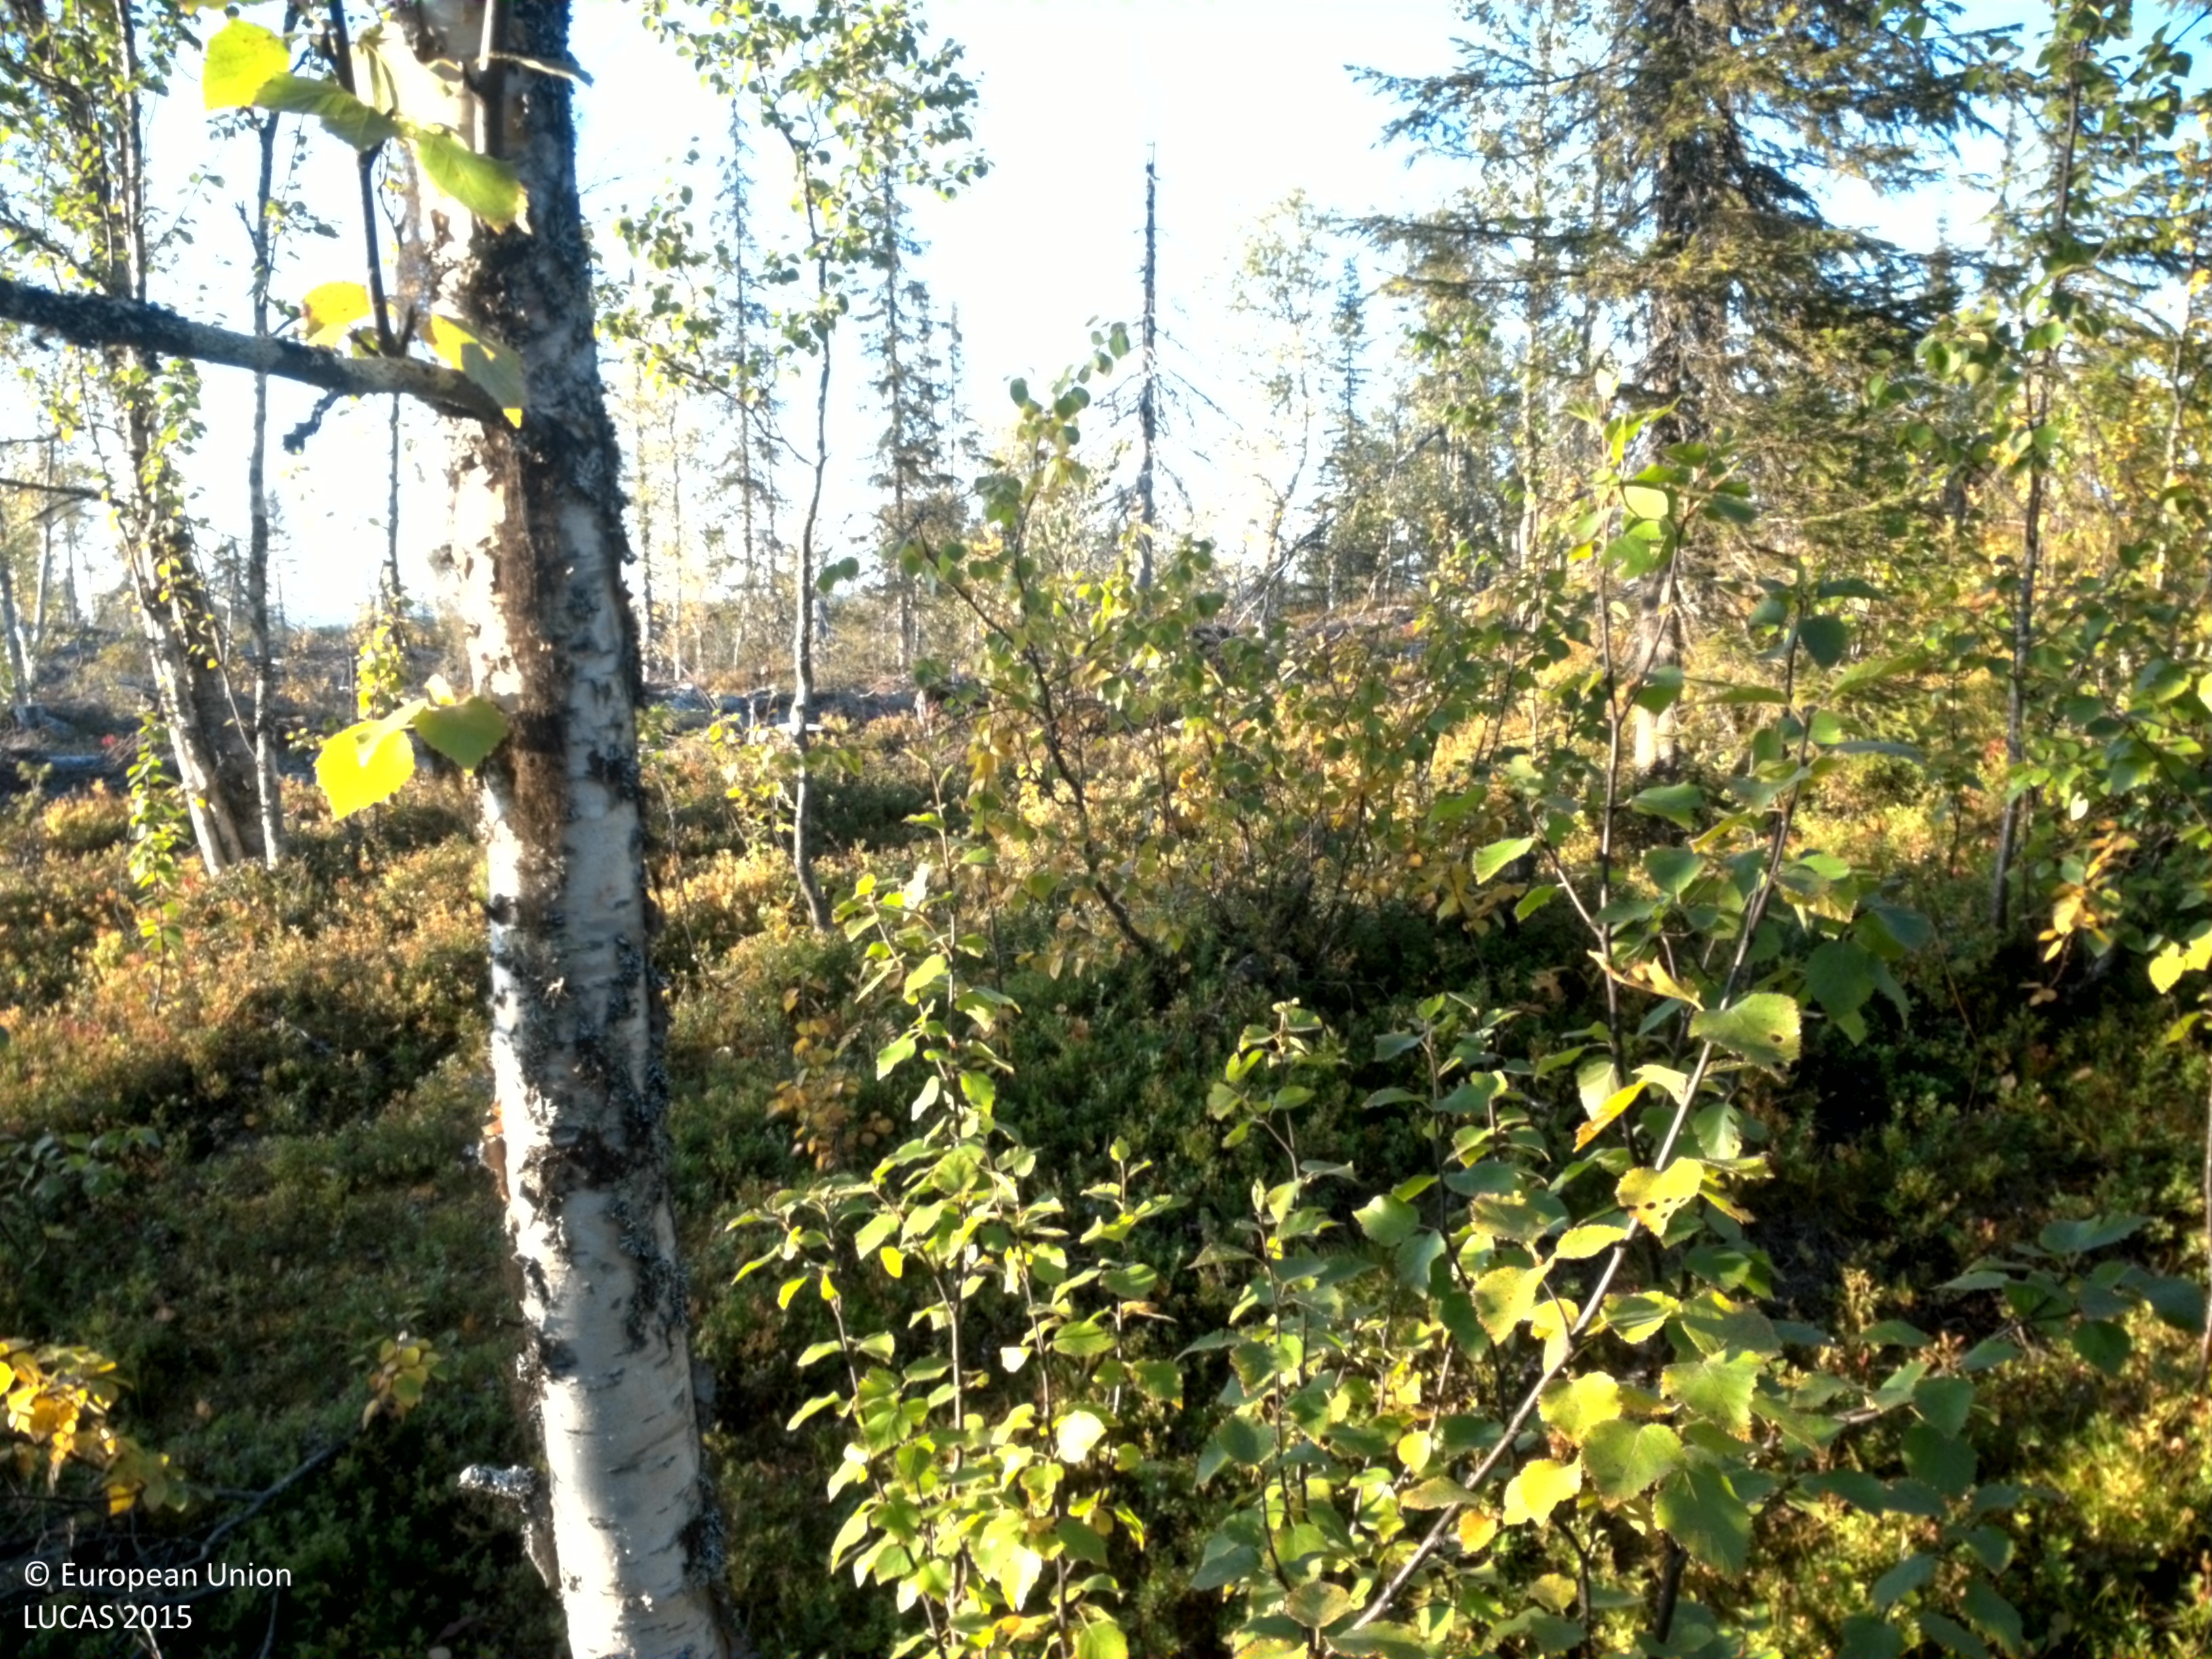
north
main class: Woodland
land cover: Spruce dominated mixed woodland
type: boreal forest
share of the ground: 25 - 50 %
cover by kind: shrubs 45 %, coniferous forest trees 15 %, broadleaved forest trees 15 %, herbaceous plants 15 %, lichens and mosses 10 %
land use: Forestry
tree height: > 5 m
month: September
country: SE
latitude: 65.3043
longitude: 16.8050
